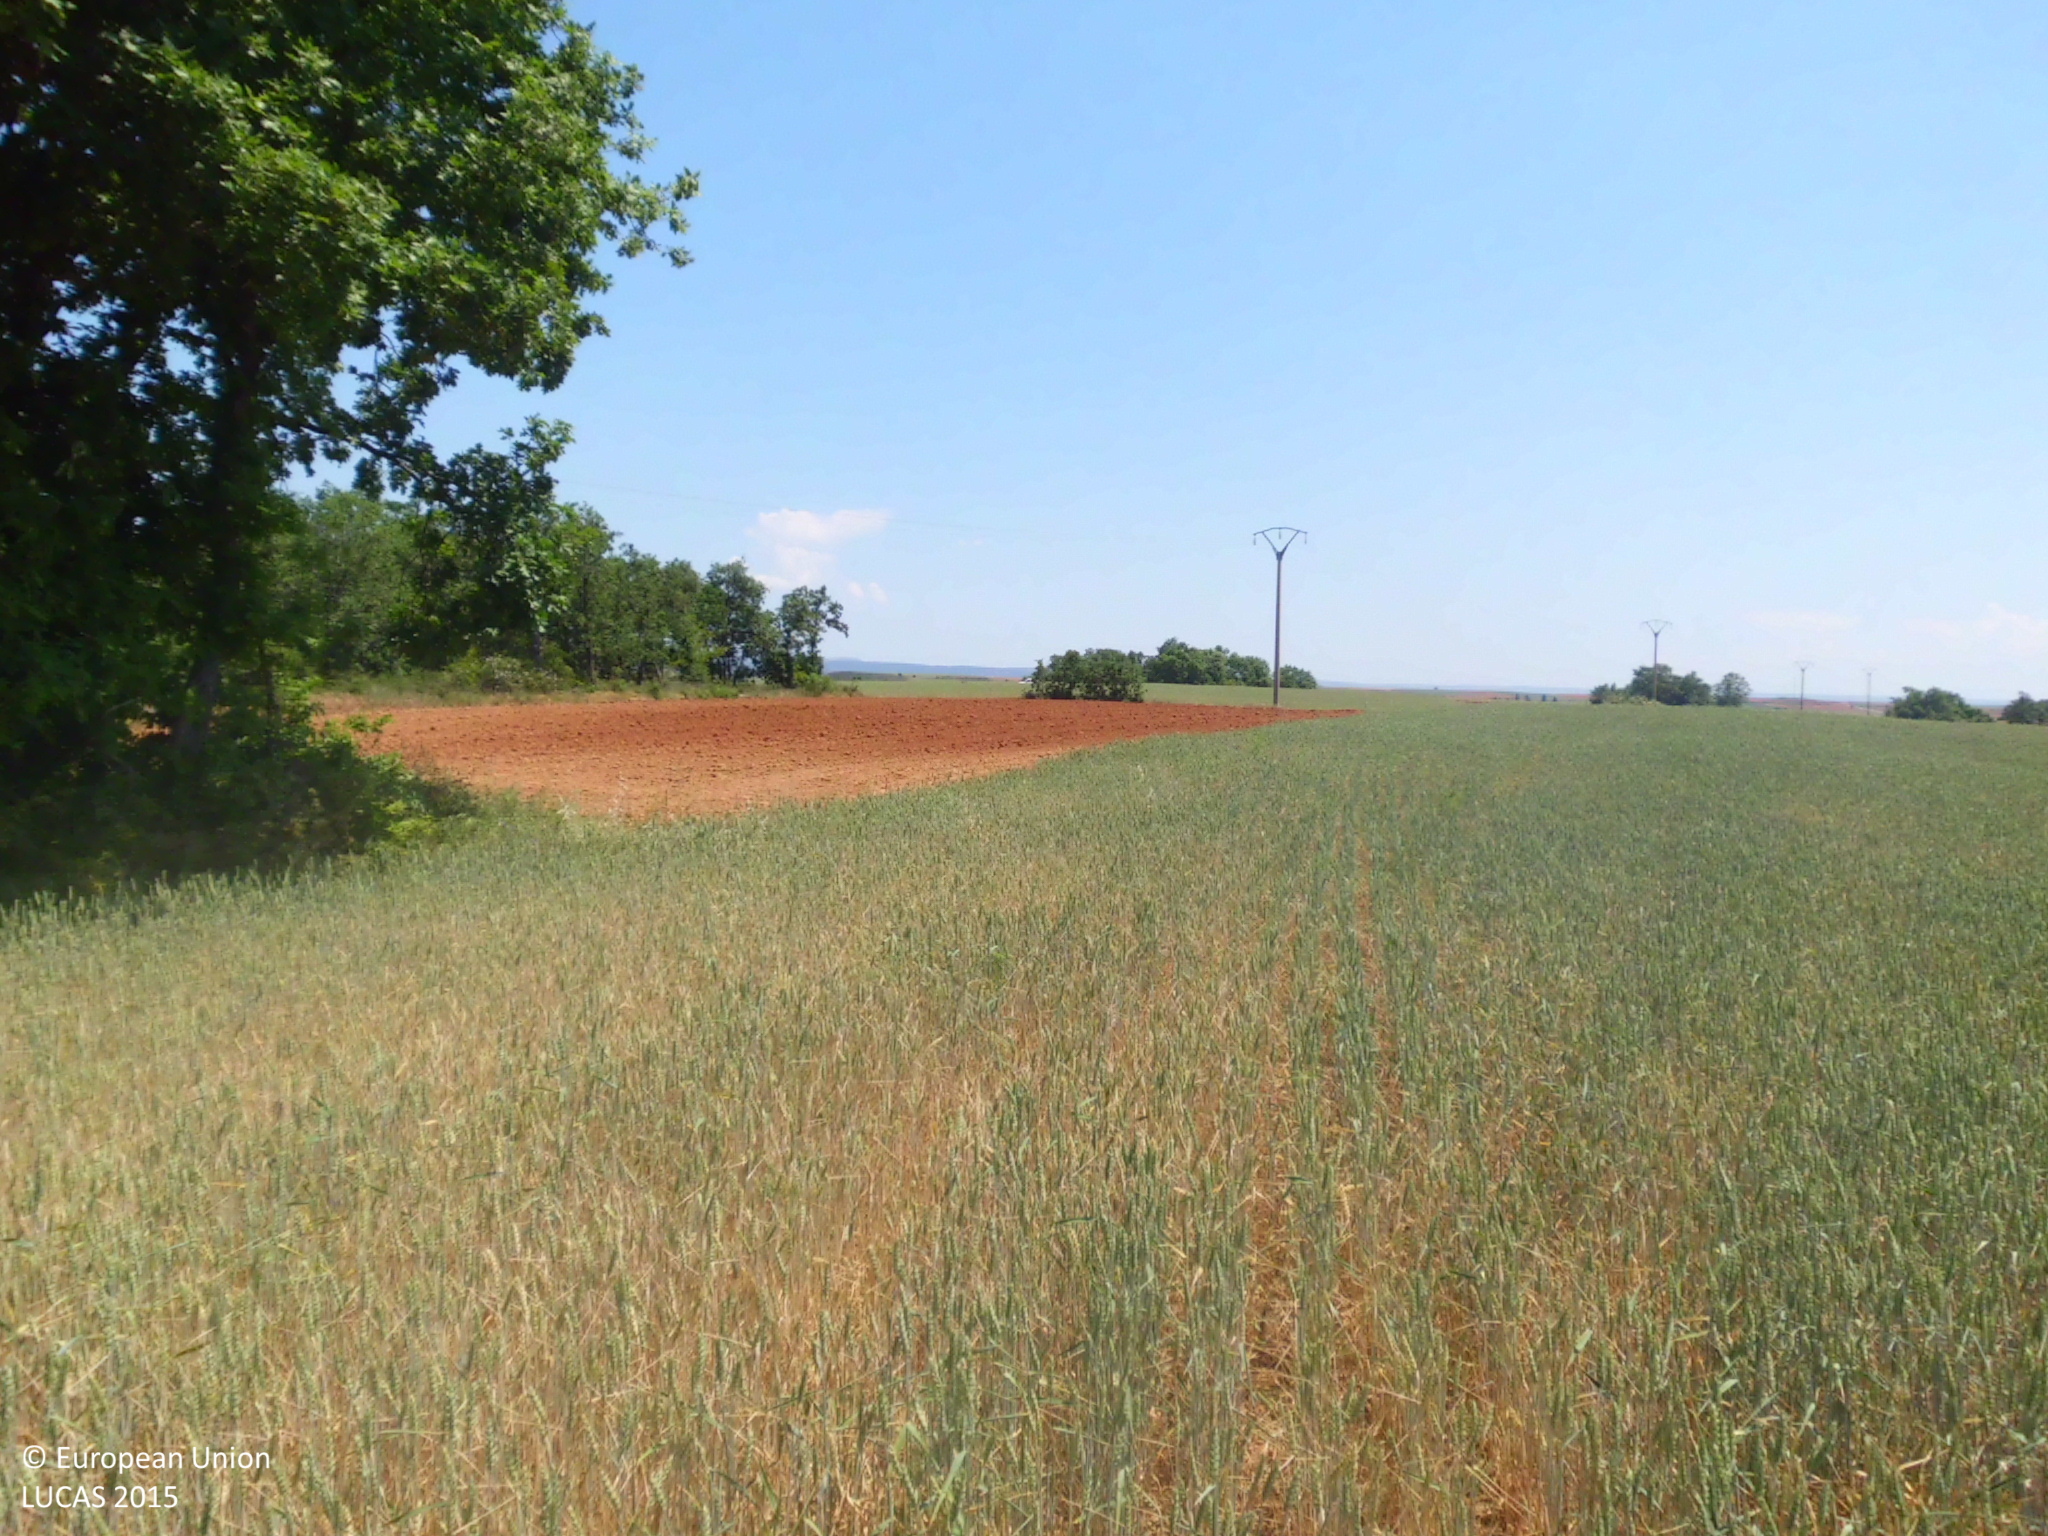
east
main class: Cropland
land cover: Common wheat
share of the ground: > 75 %
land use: Agriculture (excluding fallow land and kitchen gardens)
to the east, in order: Common wheat; Sunflower; Electric lines; Sunflower; Common wheat; Broadleaved woodland; Common wheat
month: June
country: ES
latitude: 42.5933
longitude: -4.2451
